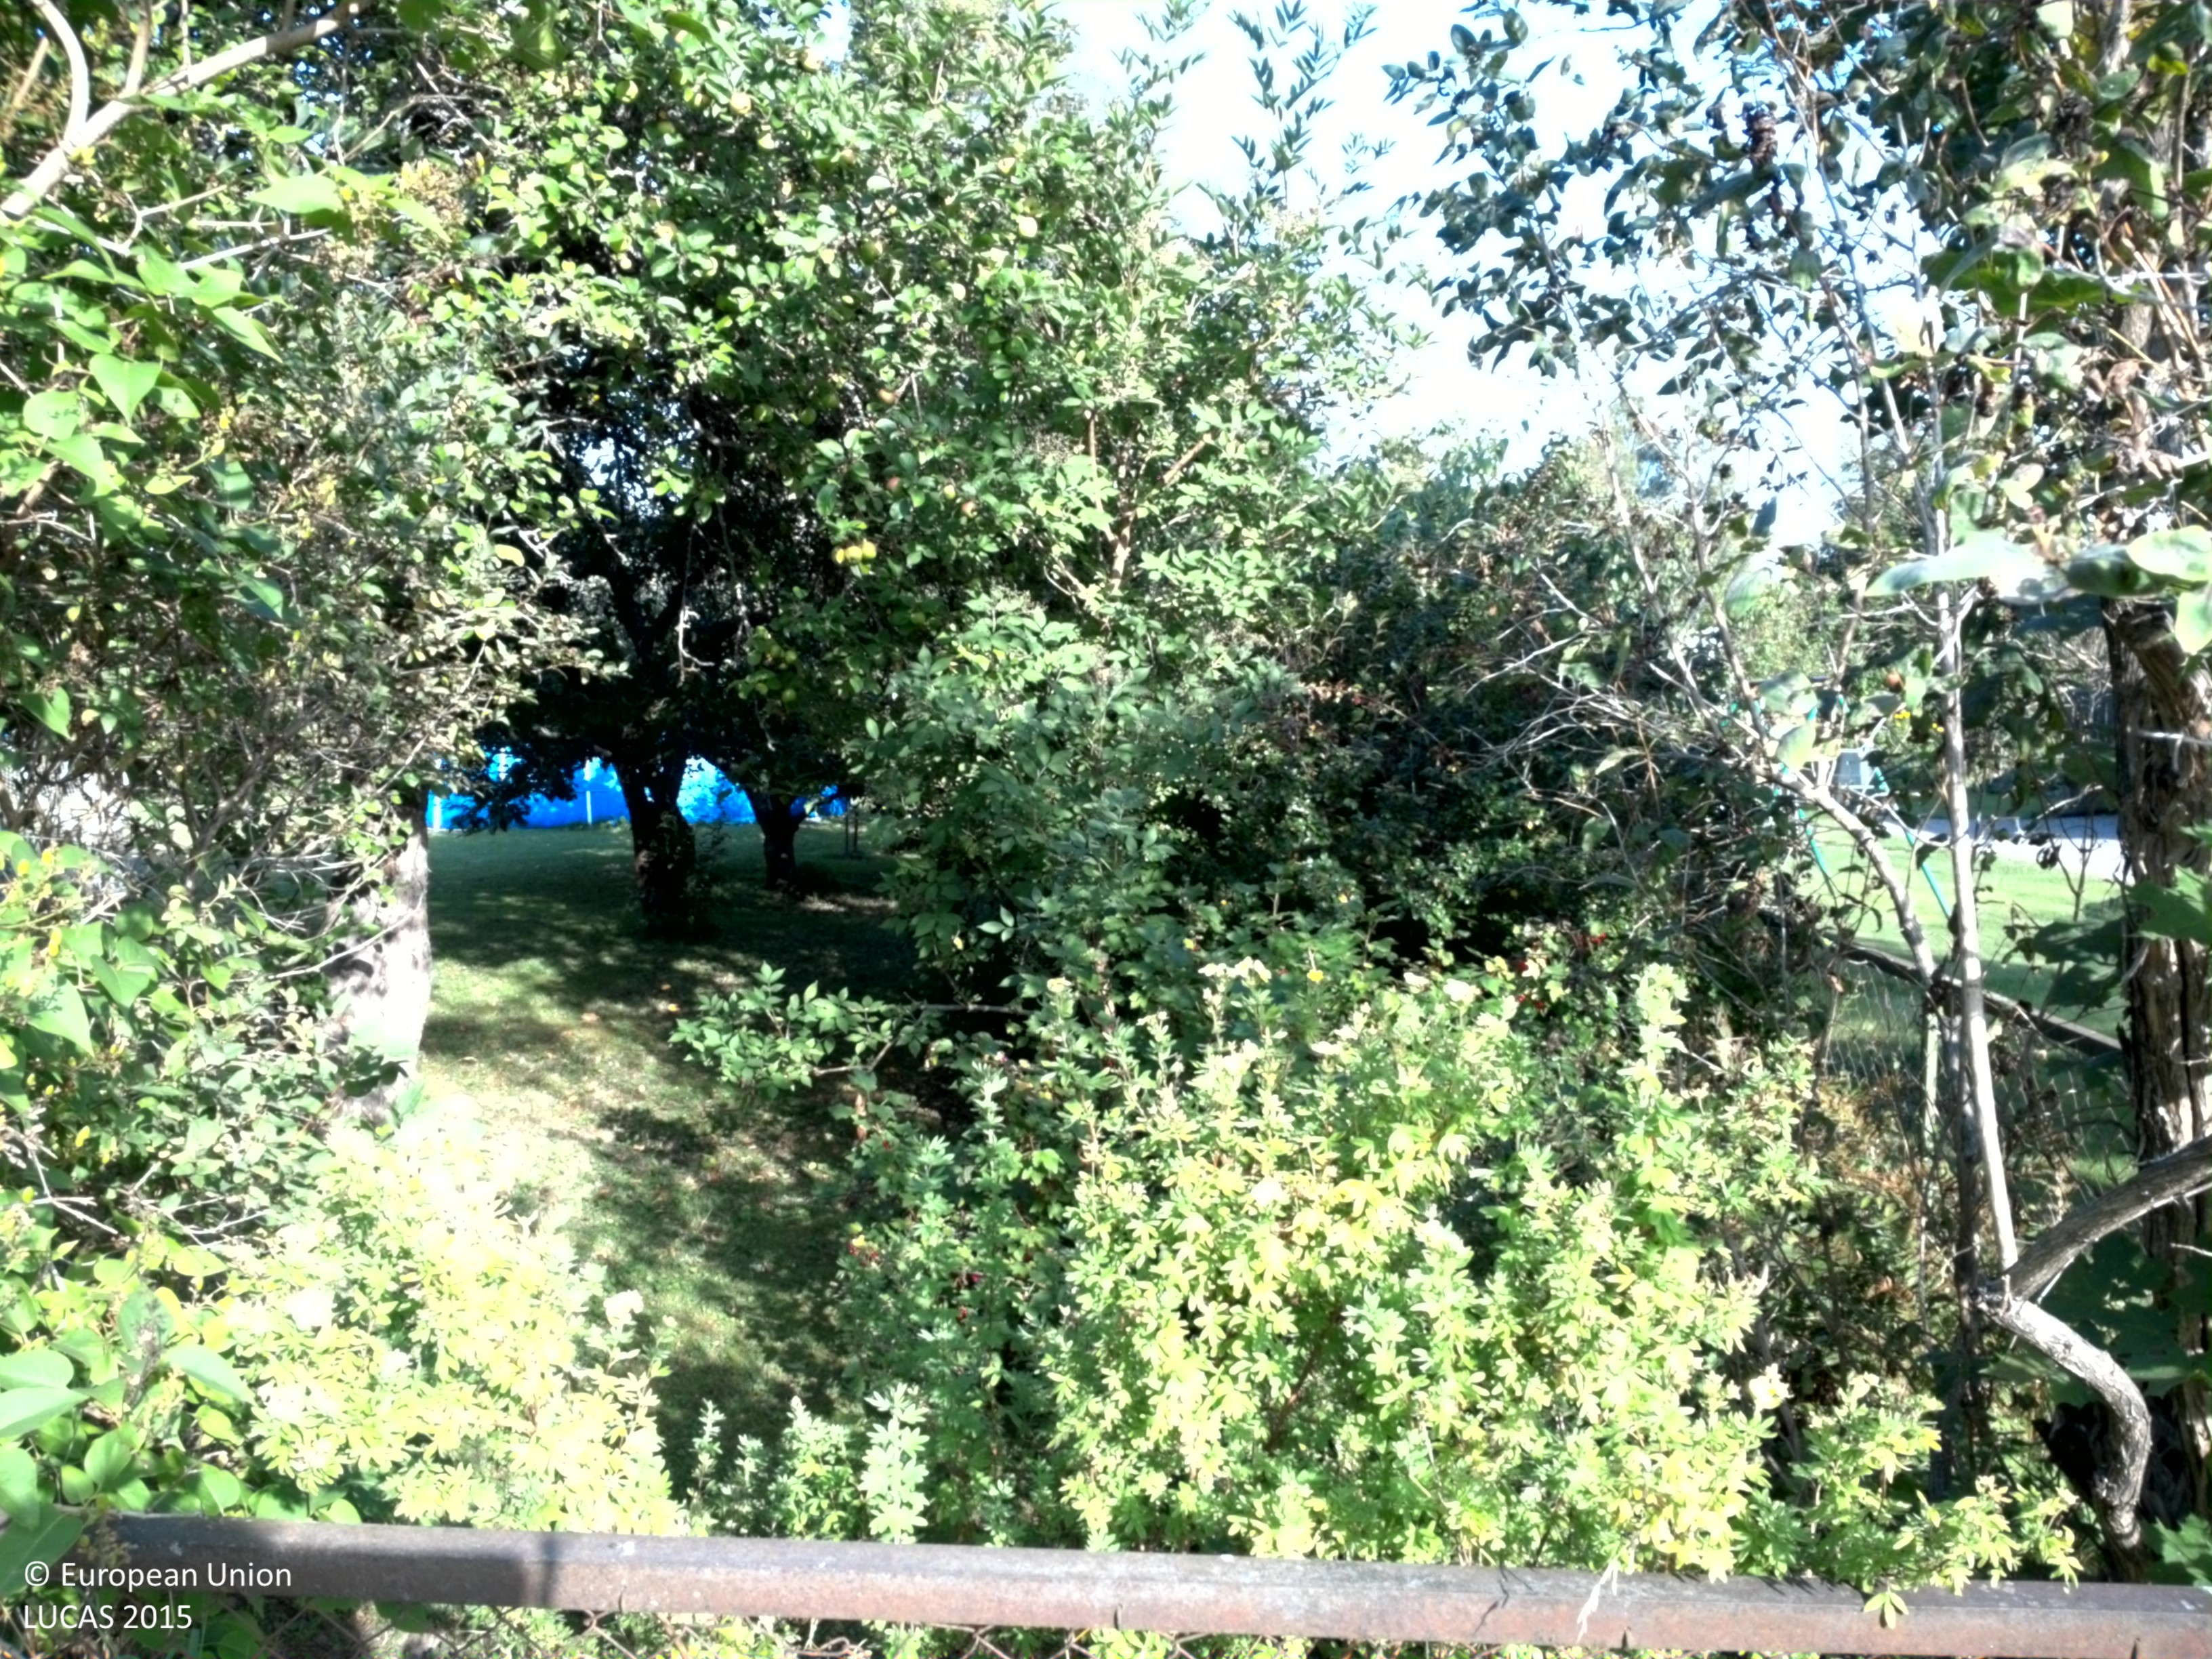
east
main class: Grassland
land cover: Grassland with sparse tree/shrub cover
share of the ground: > 75 %
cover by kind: herbaceous plants 95 %, broadleaved forest trees 5 %
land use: Residential
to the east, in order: Grassland with sparse tree/shrub cover; Artificial constructions in urban areas; Grassland without tree/shrub cover; Broadleaved woodland; Grassland without tree/shrub cover; Grass margins; Ditches and canals; Paved roads, cycling and walking lanes; Ditches and canals; Grass margins; Broadleaved woodland
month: August
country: SE
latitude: 60.0230
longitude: 17.7272
